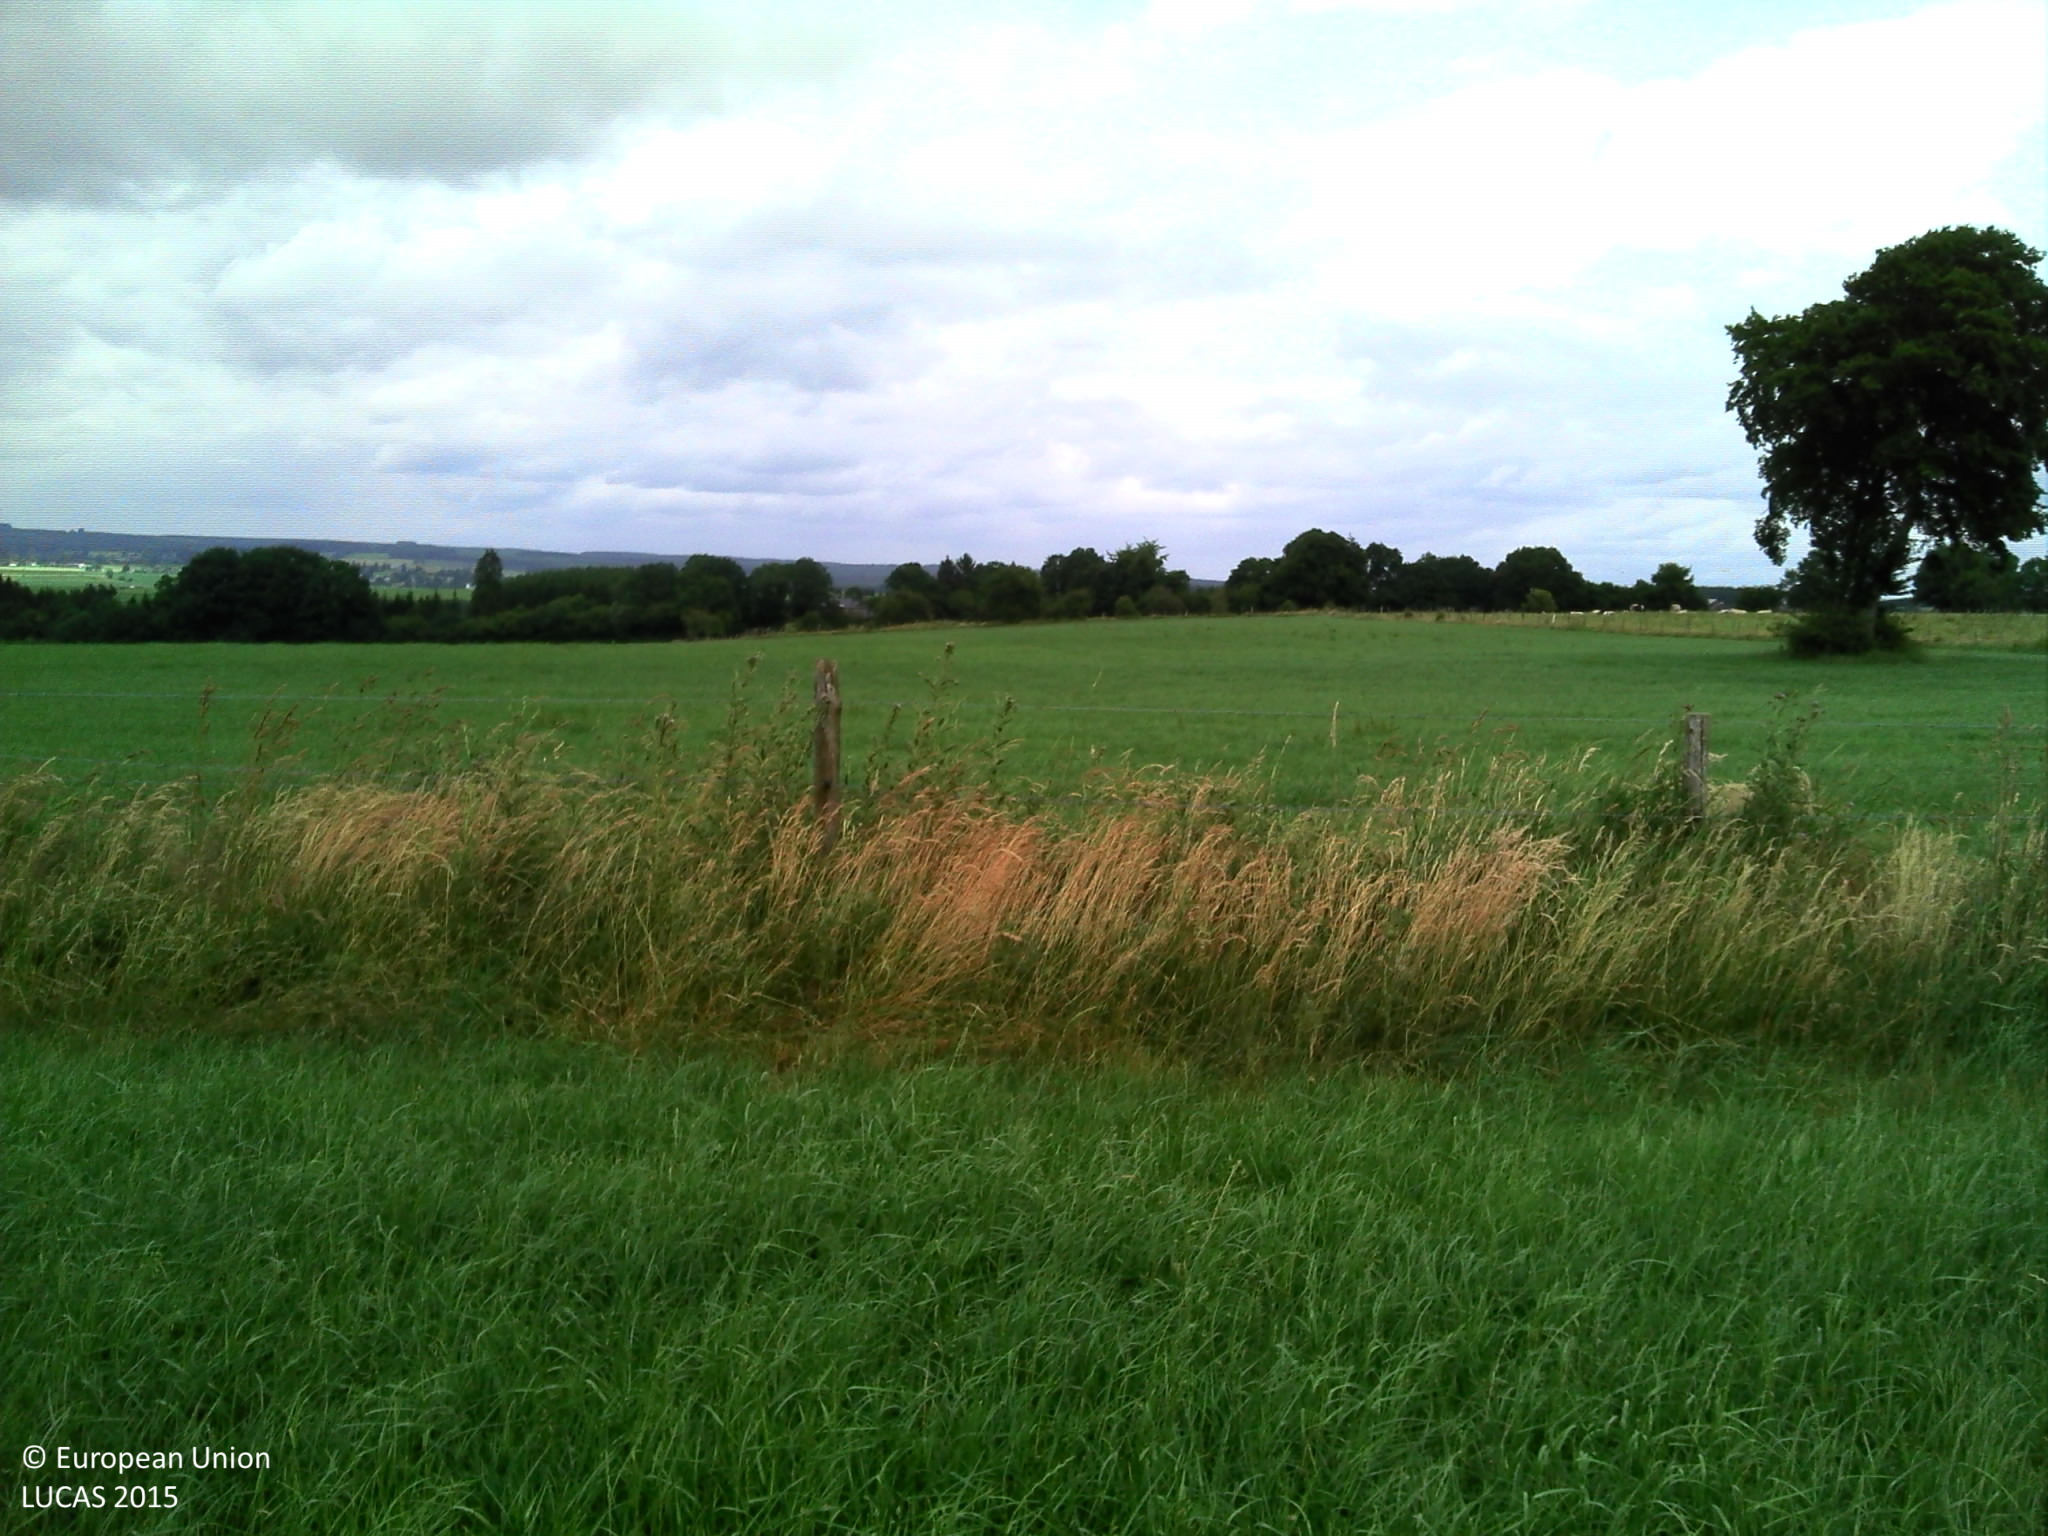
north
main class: Grassland
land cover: Grassland without tree/shrub cover
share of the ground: > 75 %
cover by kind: herbaceous plants 100 %
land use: Agriculture (excluding fallow land and kitchen gardens)
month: July
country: BE
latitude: 50.1465
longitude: 5.8987
